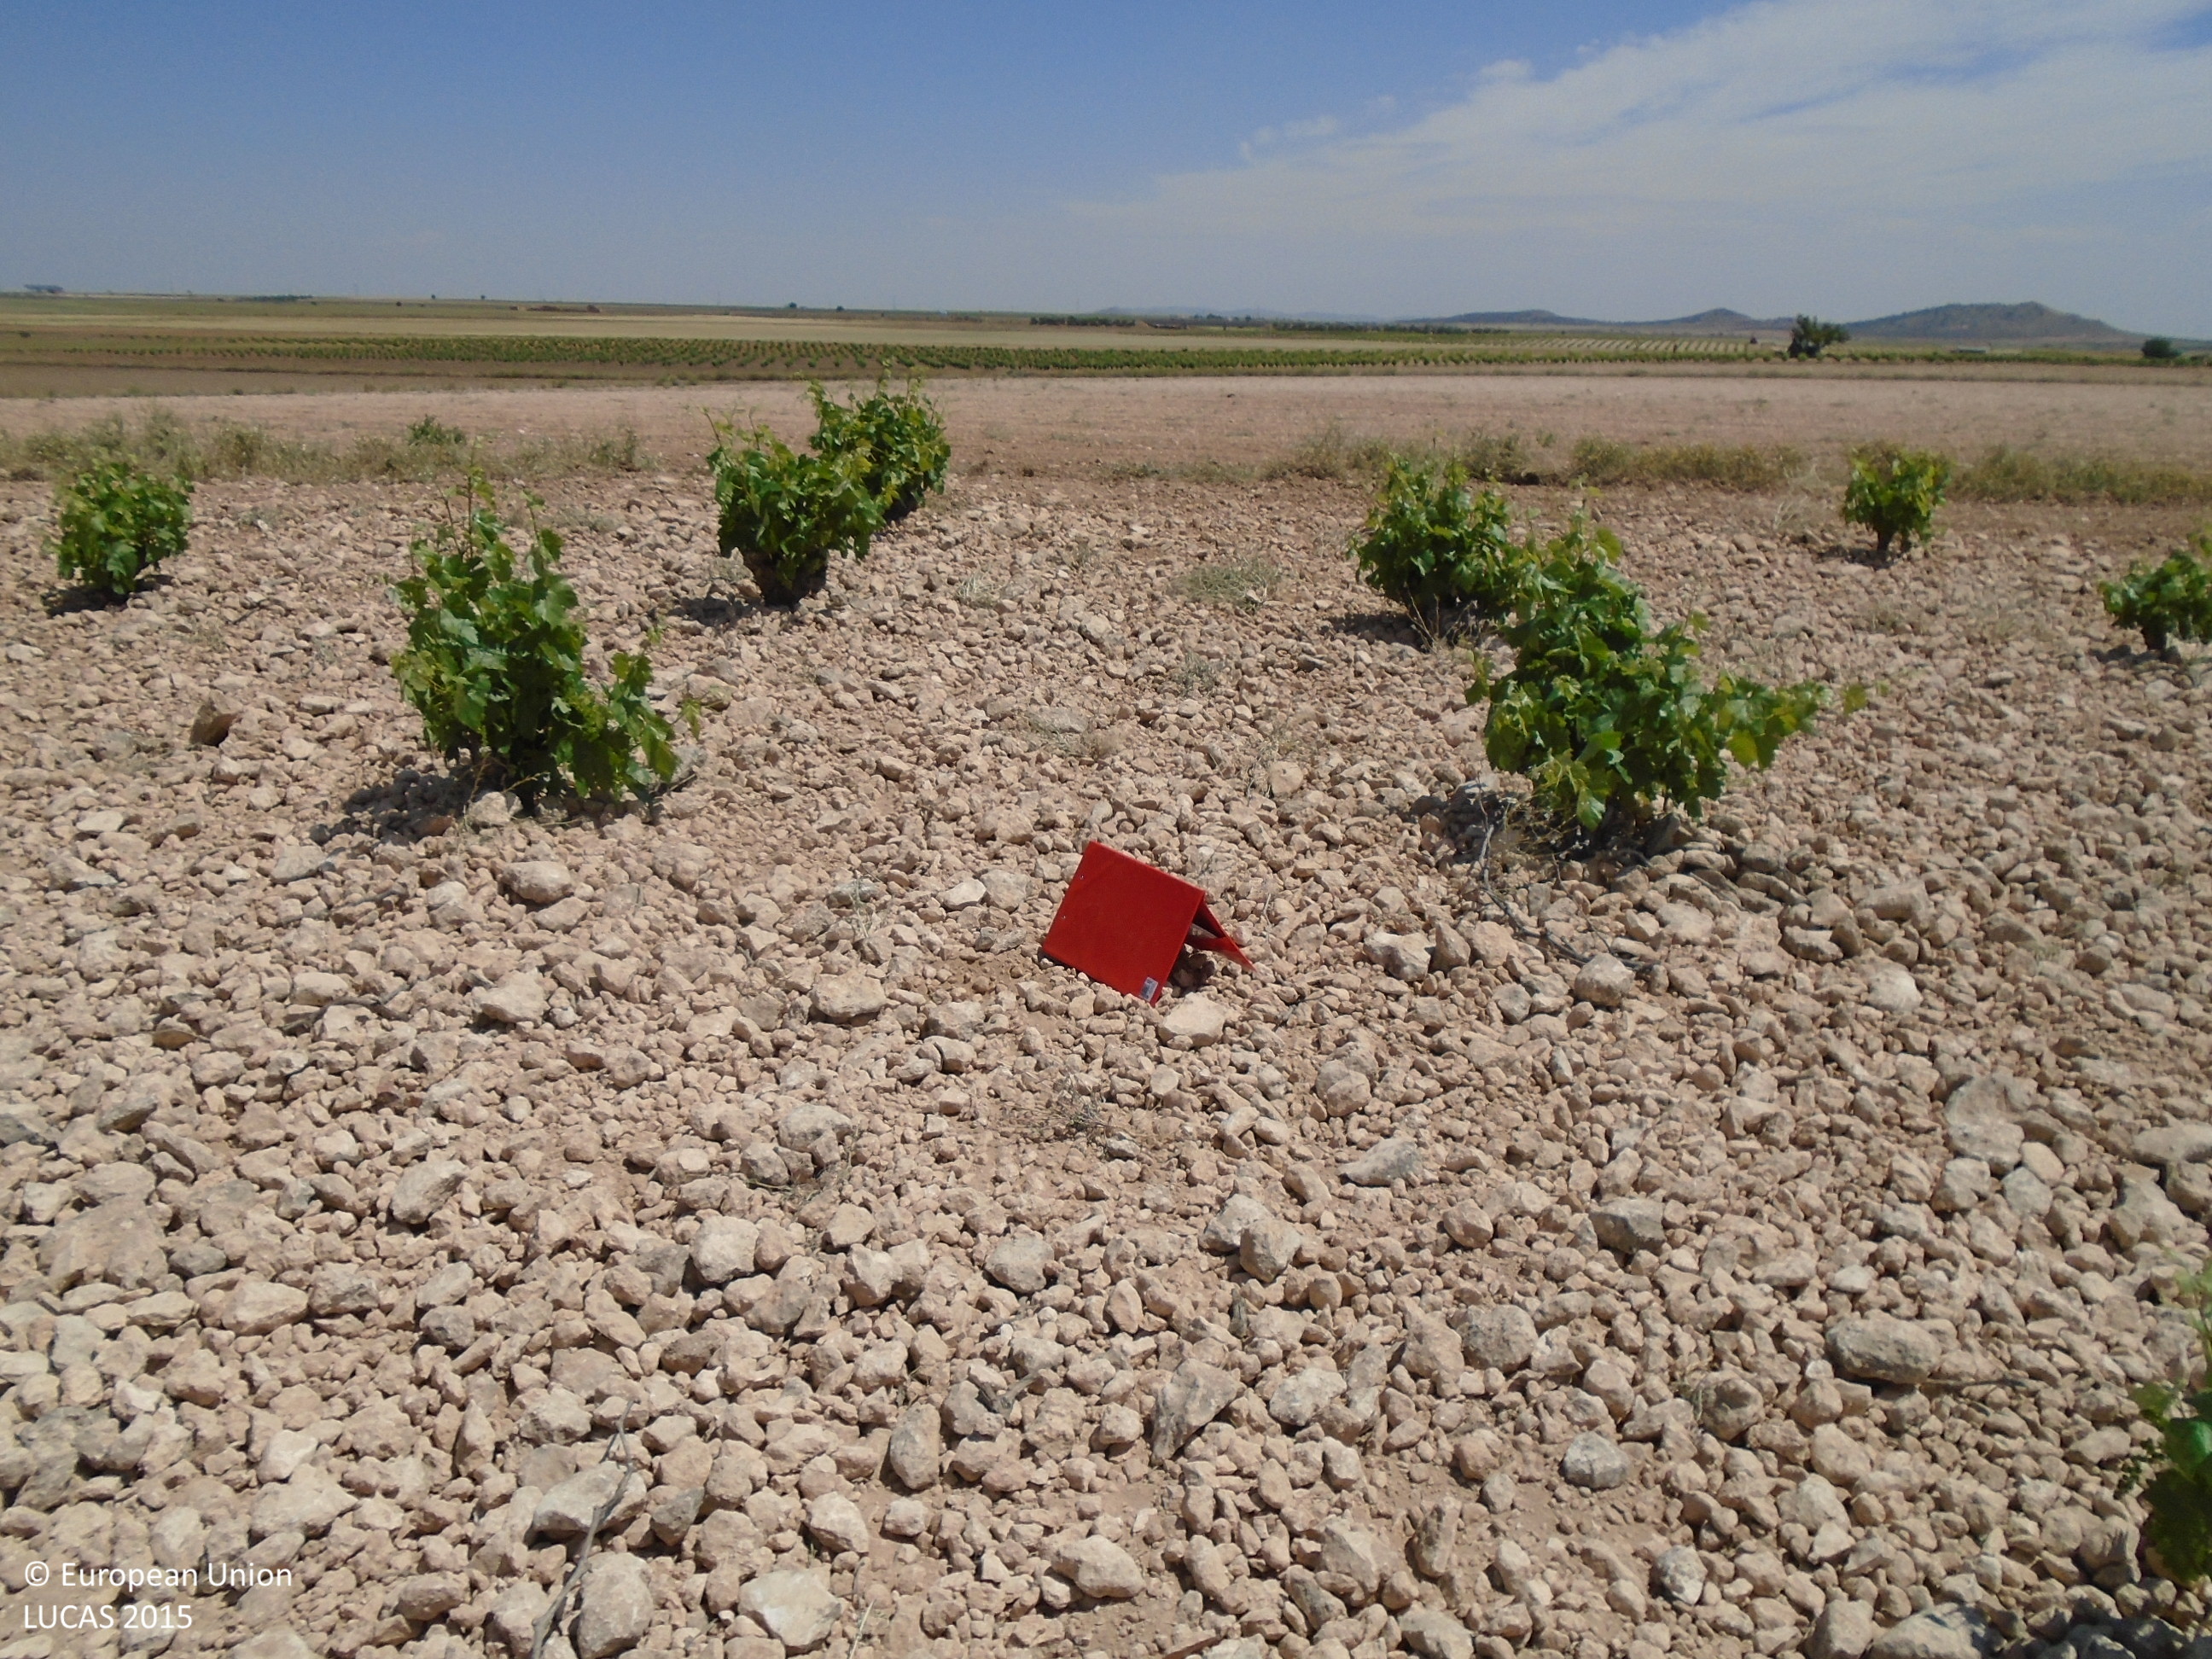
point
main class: Cropland
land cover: Vineyards
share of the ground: 10 - 25 %
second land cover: Other bare soil
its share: > 75 %
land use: Agriculture (excluding fallow land and kitchen gardens)
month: May
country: ES
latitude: 39.5253
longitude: -3.6708
